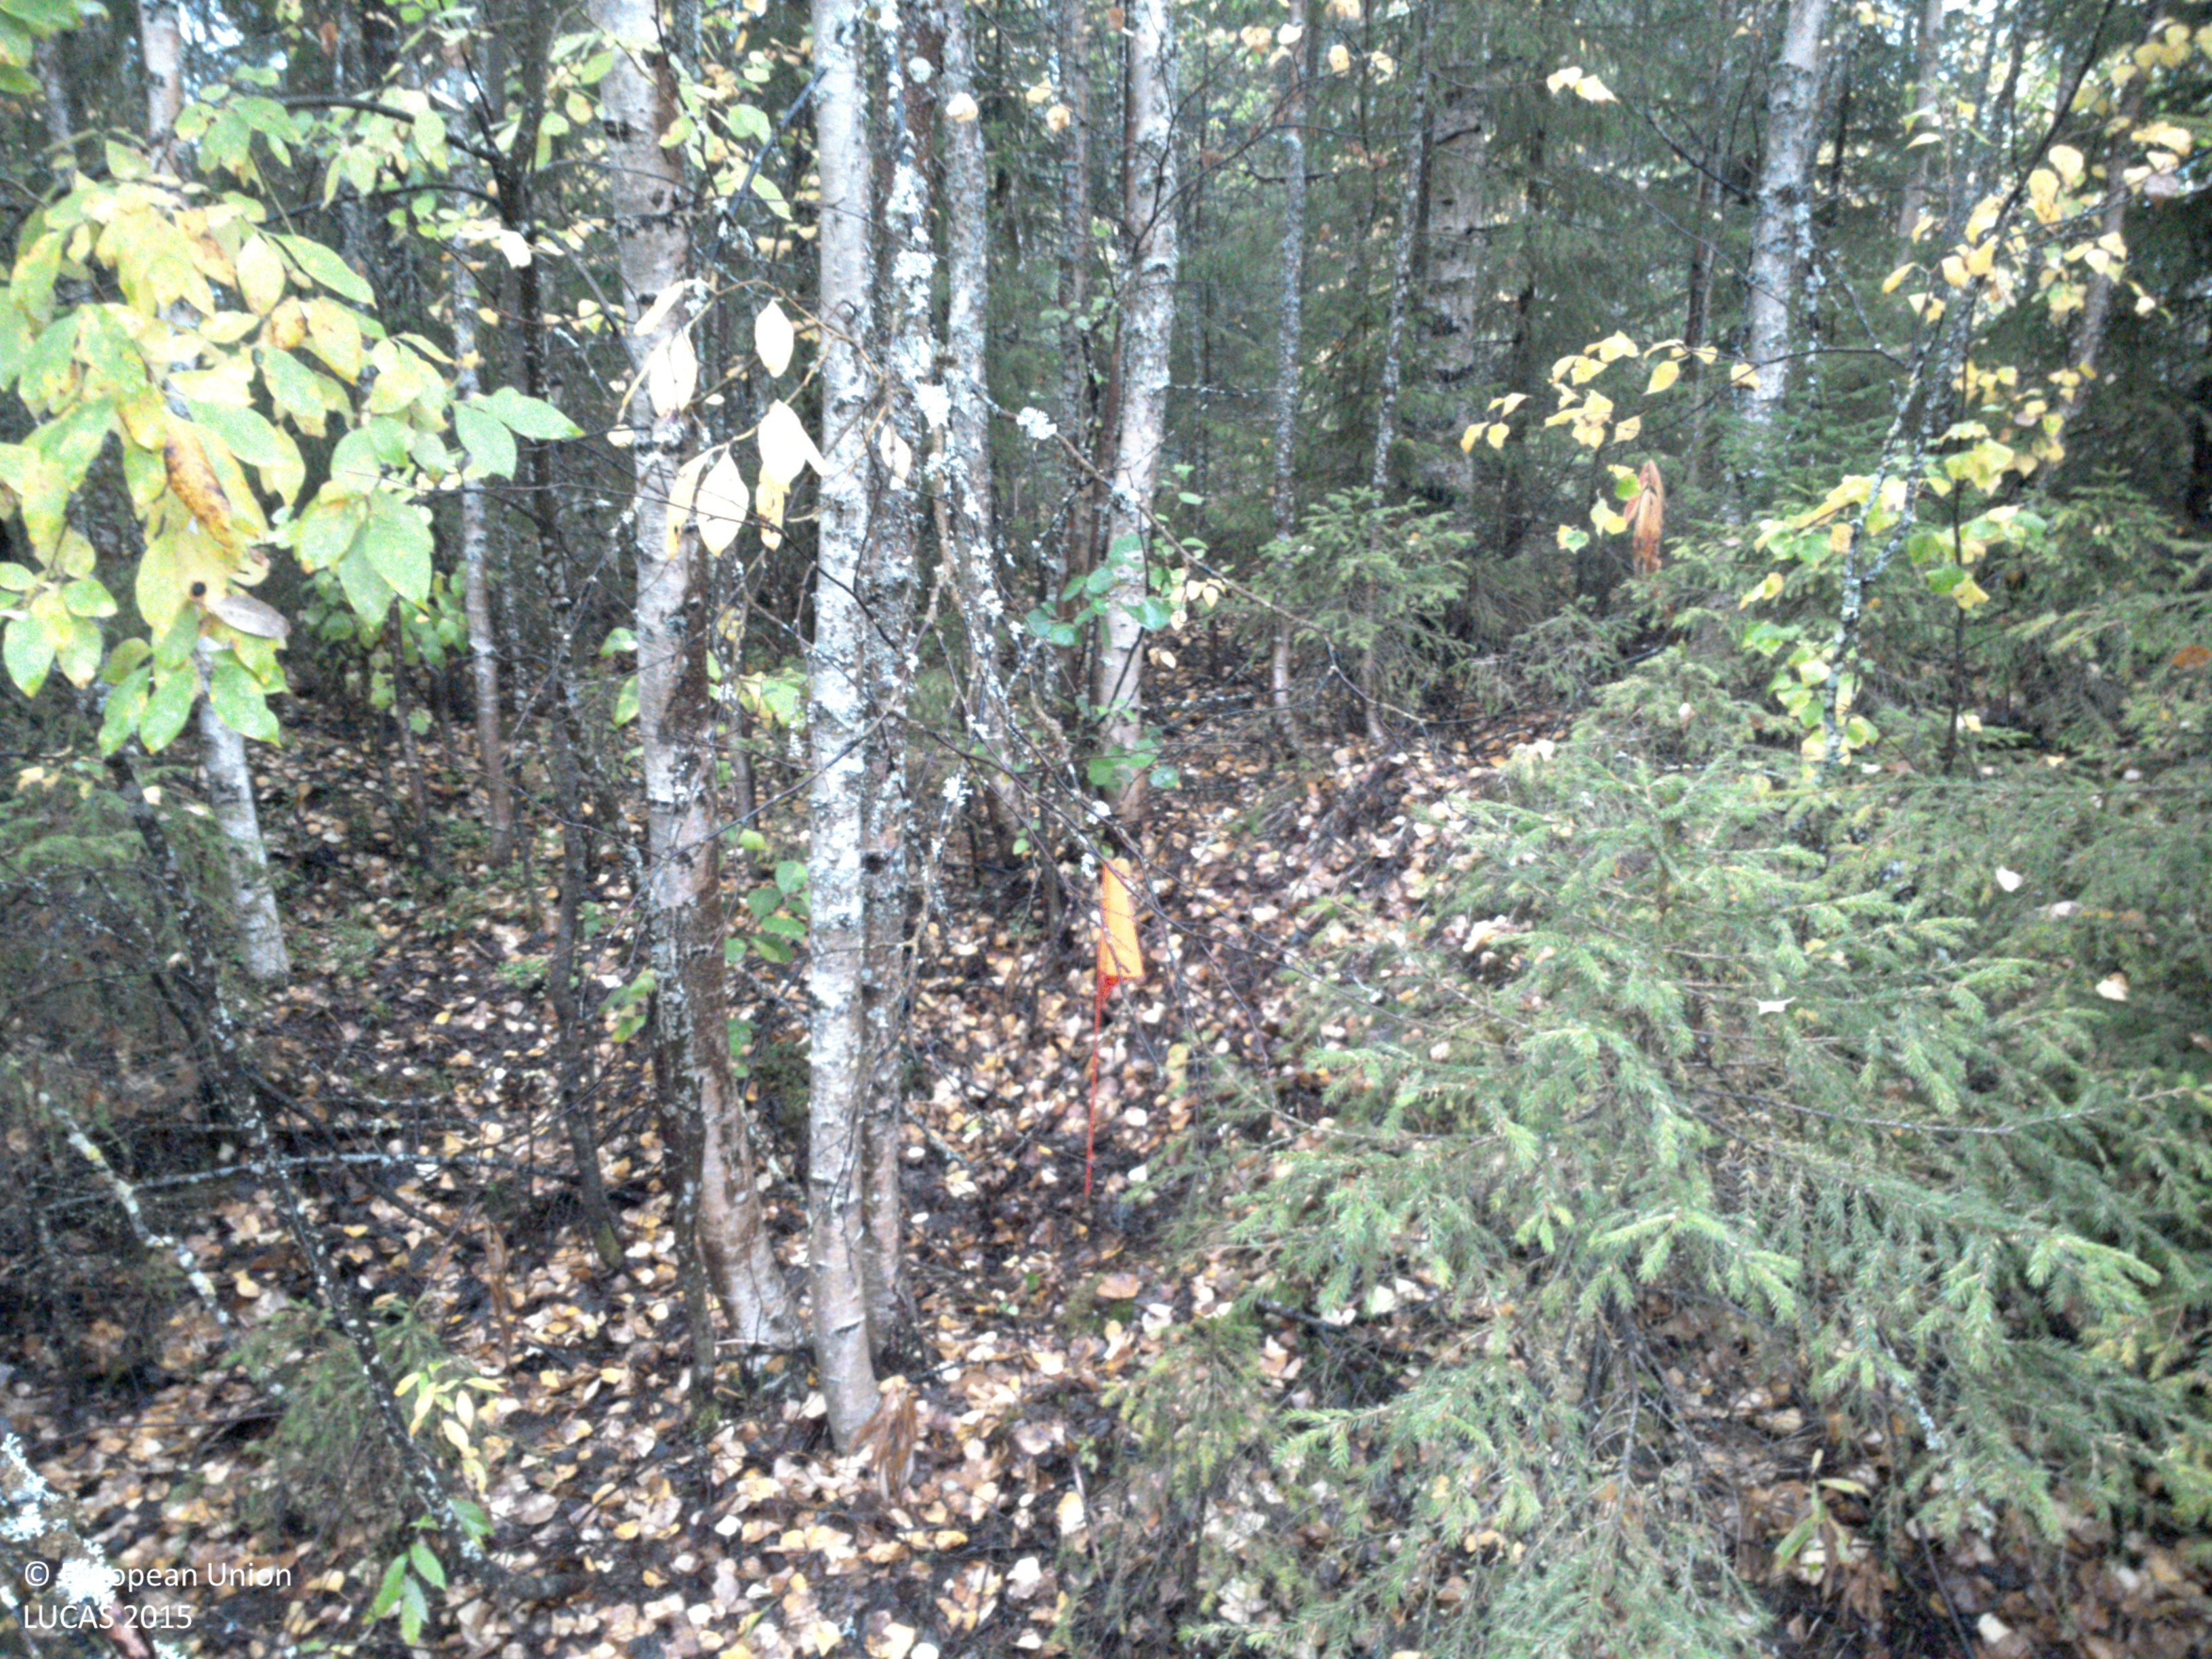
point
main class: Woodland
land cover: Spruce dominated mixed woodland
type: hemiboreal forest and nemoral coniferous forest and mixed broadleaved-coniferous forest
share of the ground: > 75 %
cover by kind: coniferous forest trees 60 %, broadleaved forest trees 20 %, shrubs 10 %, unconsolidated bare surface 10 %
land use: Forestry
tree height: > 5 m
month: September
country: SE
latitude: 64.9395
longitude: 19.3829
